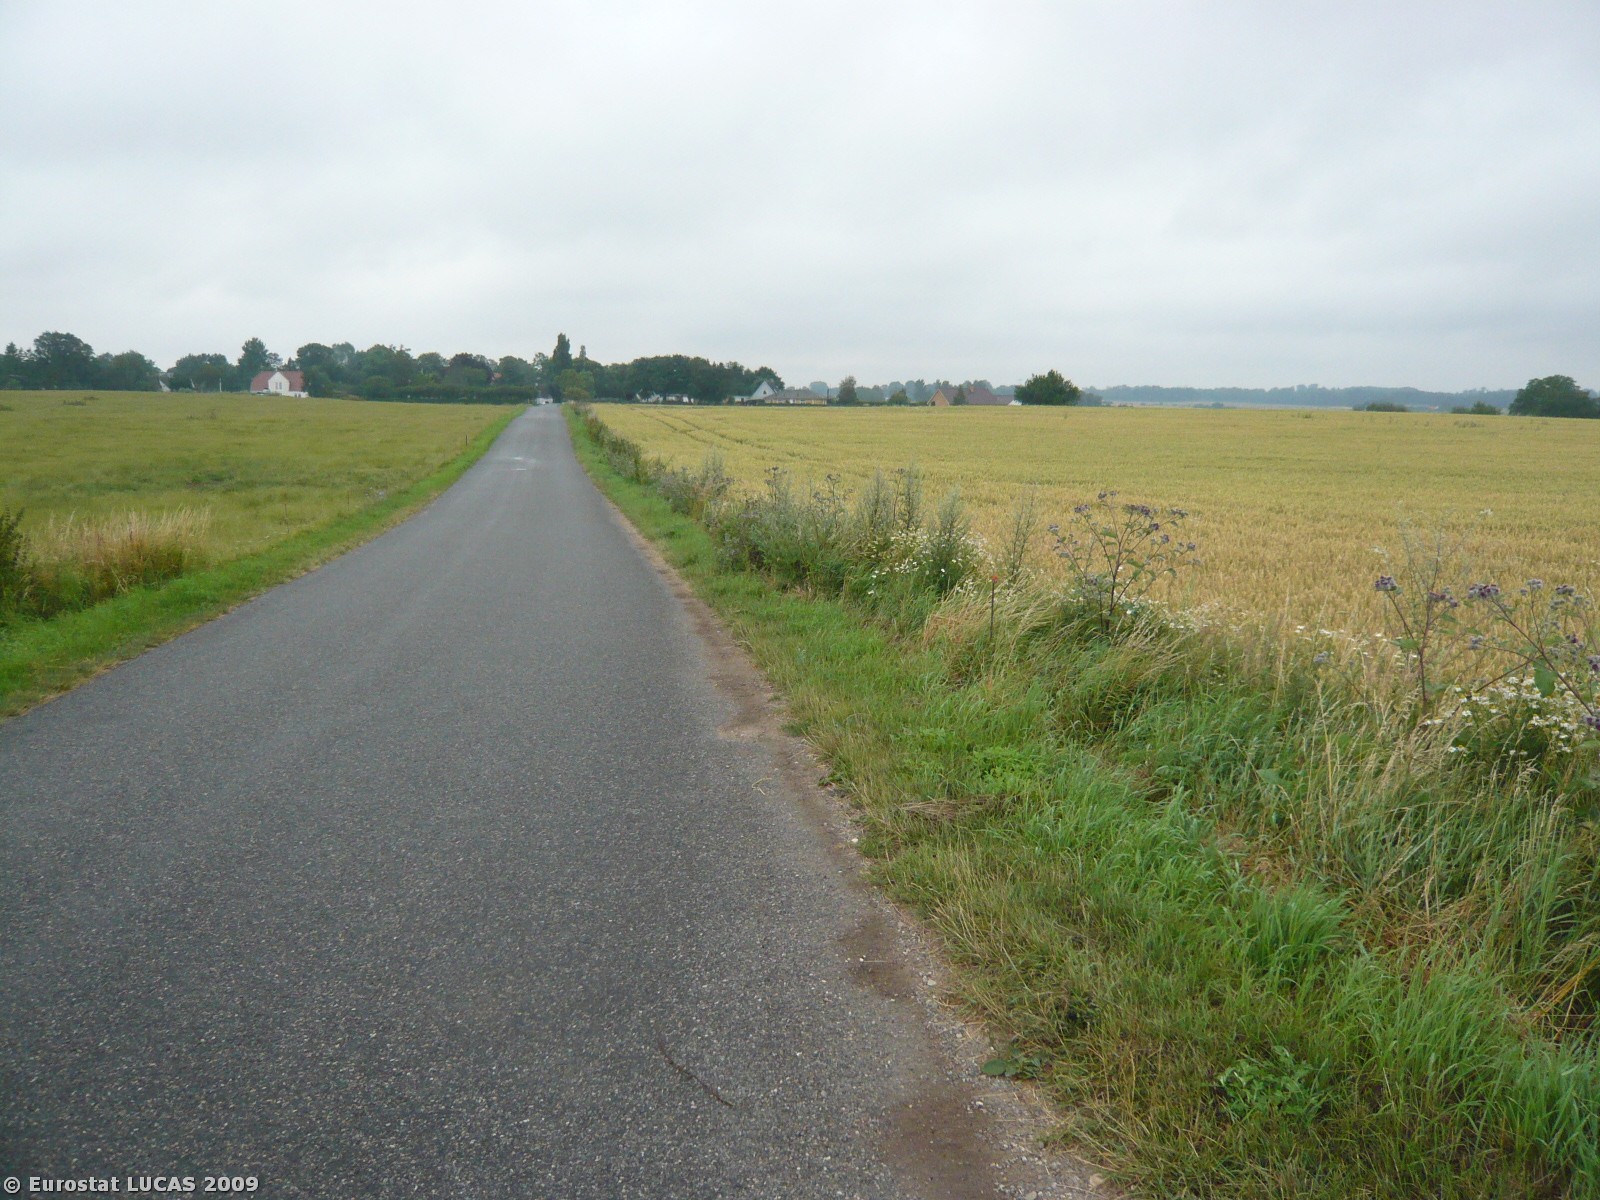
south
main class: Cropland
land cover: Common wheat
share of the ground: > 75 %
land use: Agriculture (excluding fallow land and kitchen gardens)
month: July
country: DK
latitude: 55.6884
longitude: 11.8912
